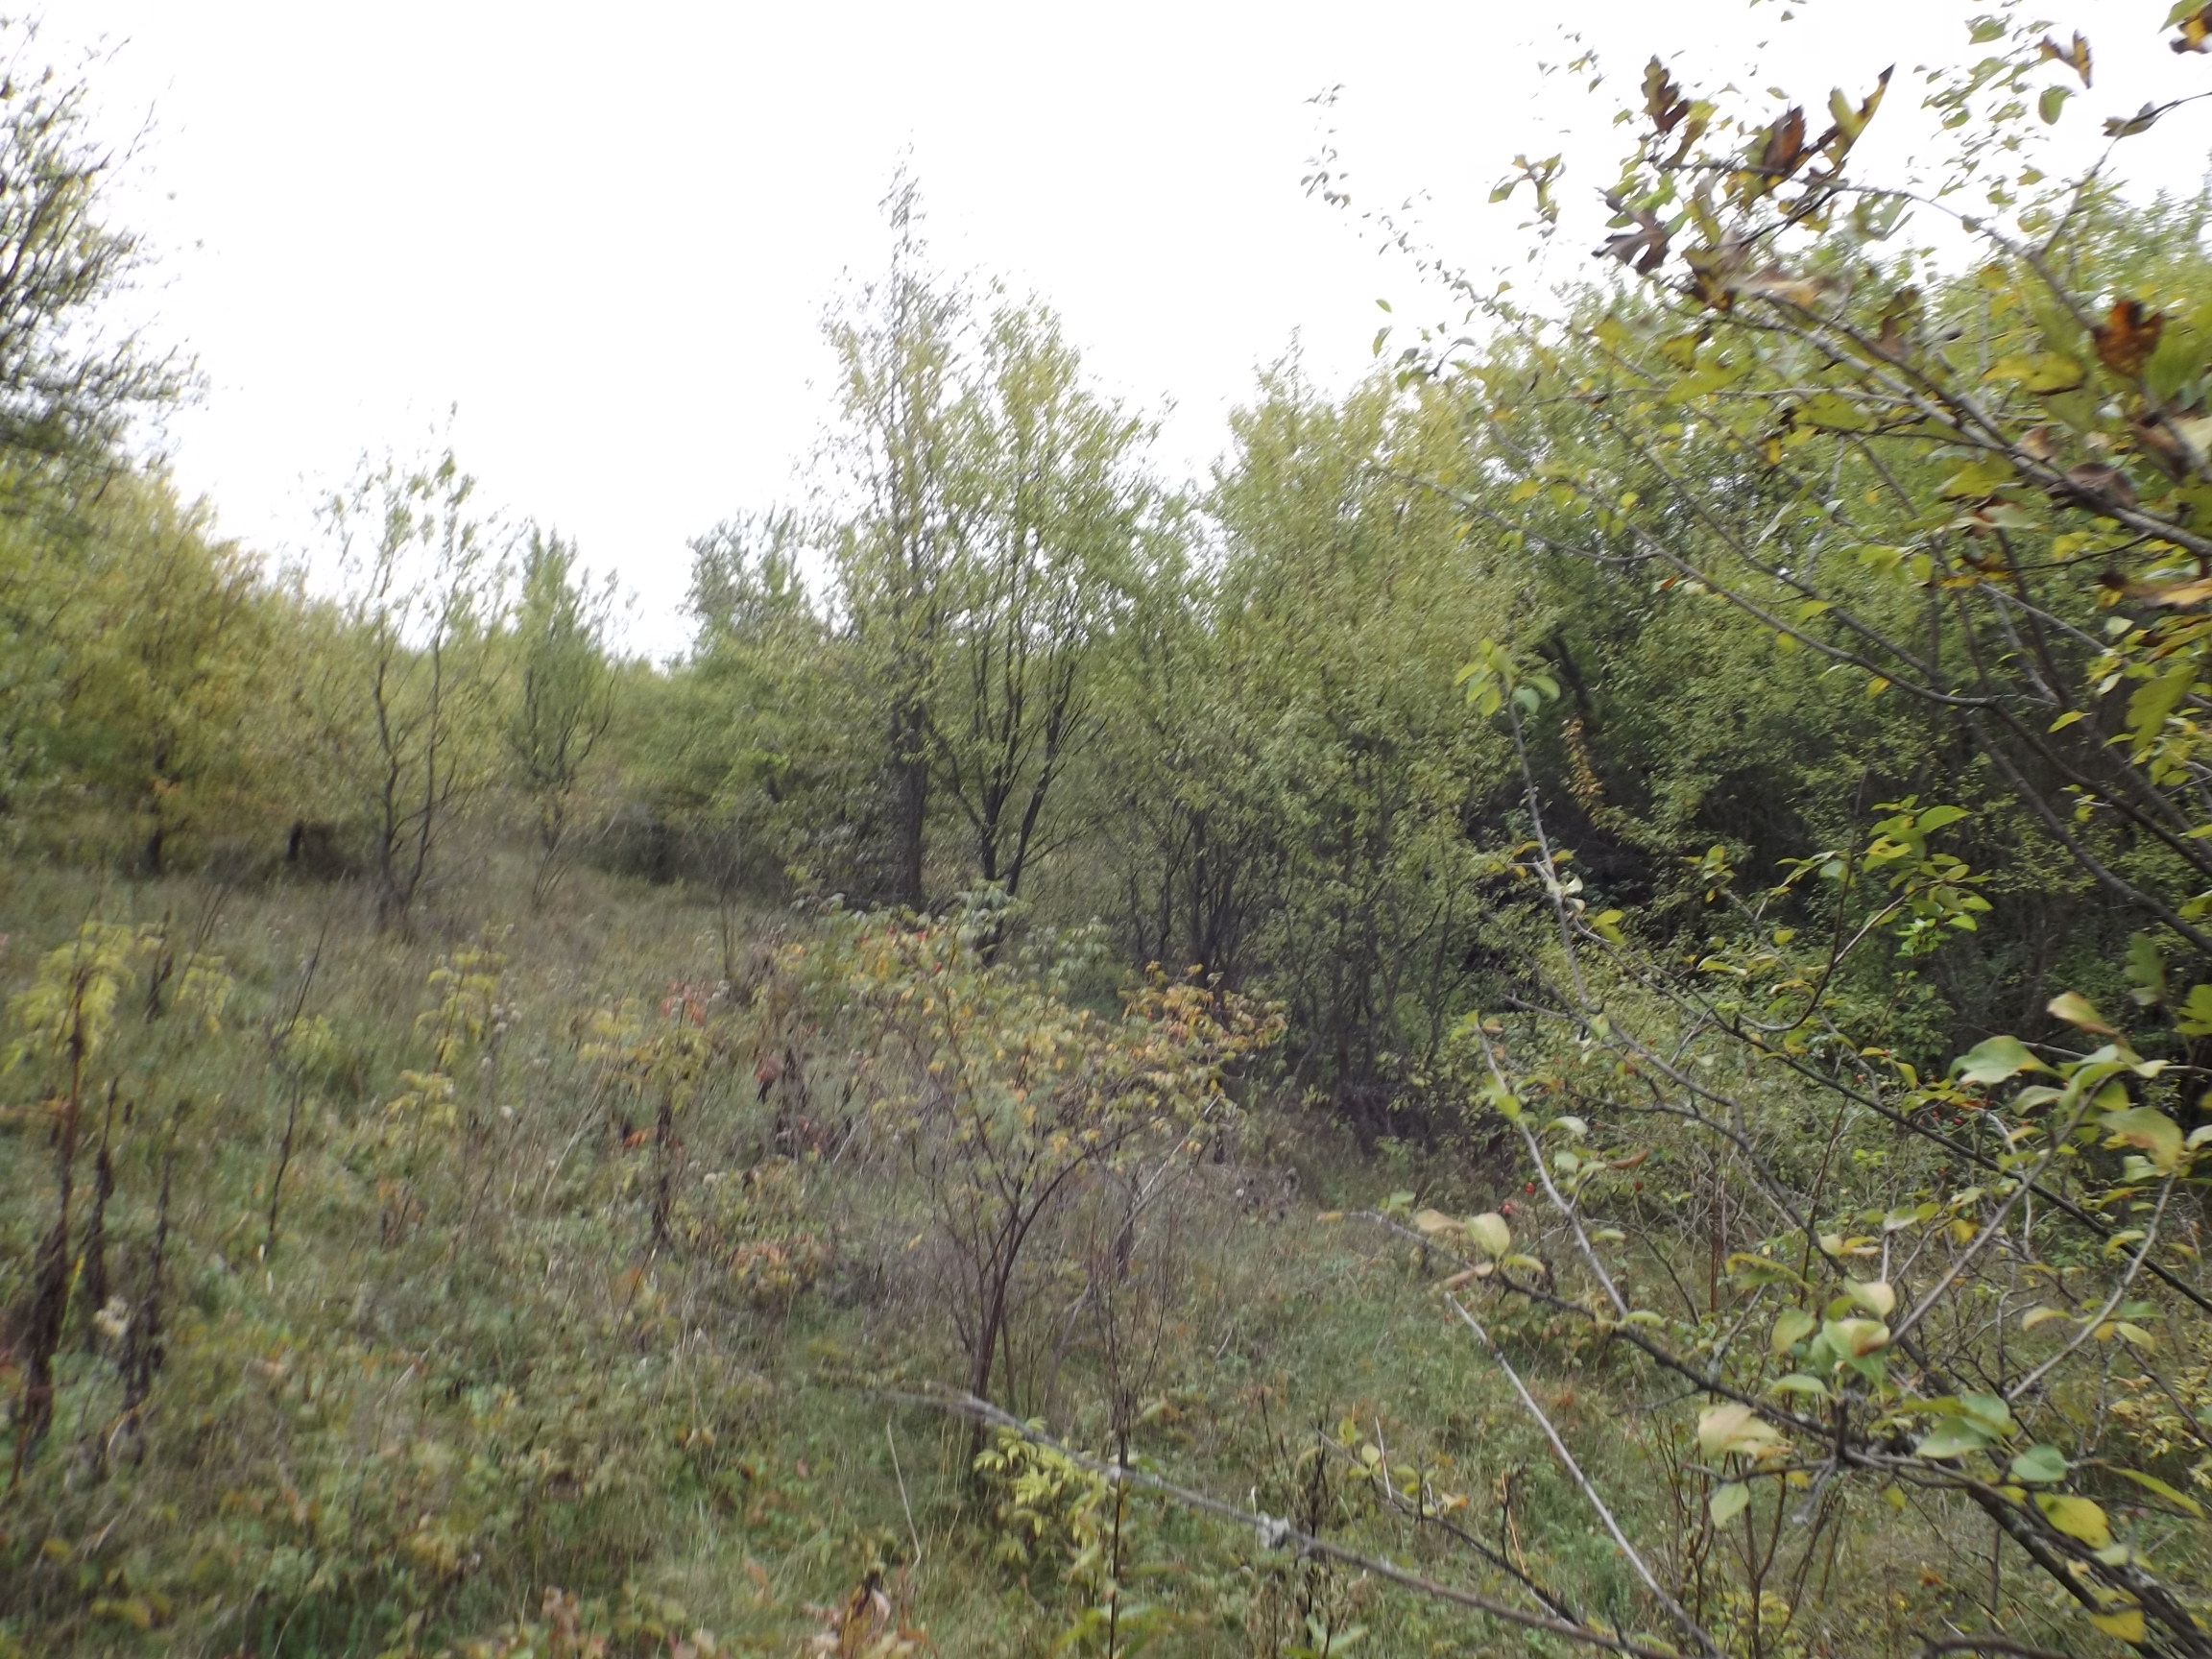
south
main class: Shrubland
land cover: Shrubland with sparse tree cover
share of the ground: > 75 %
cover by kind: shrubs 65 %, herbaceous plants 30 %, broadleaved forest trees 5 %
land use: Semi-natural and natural areas not in use
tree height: > 5 m
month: October
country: BG
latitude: 44.0313
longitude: 26.8263
